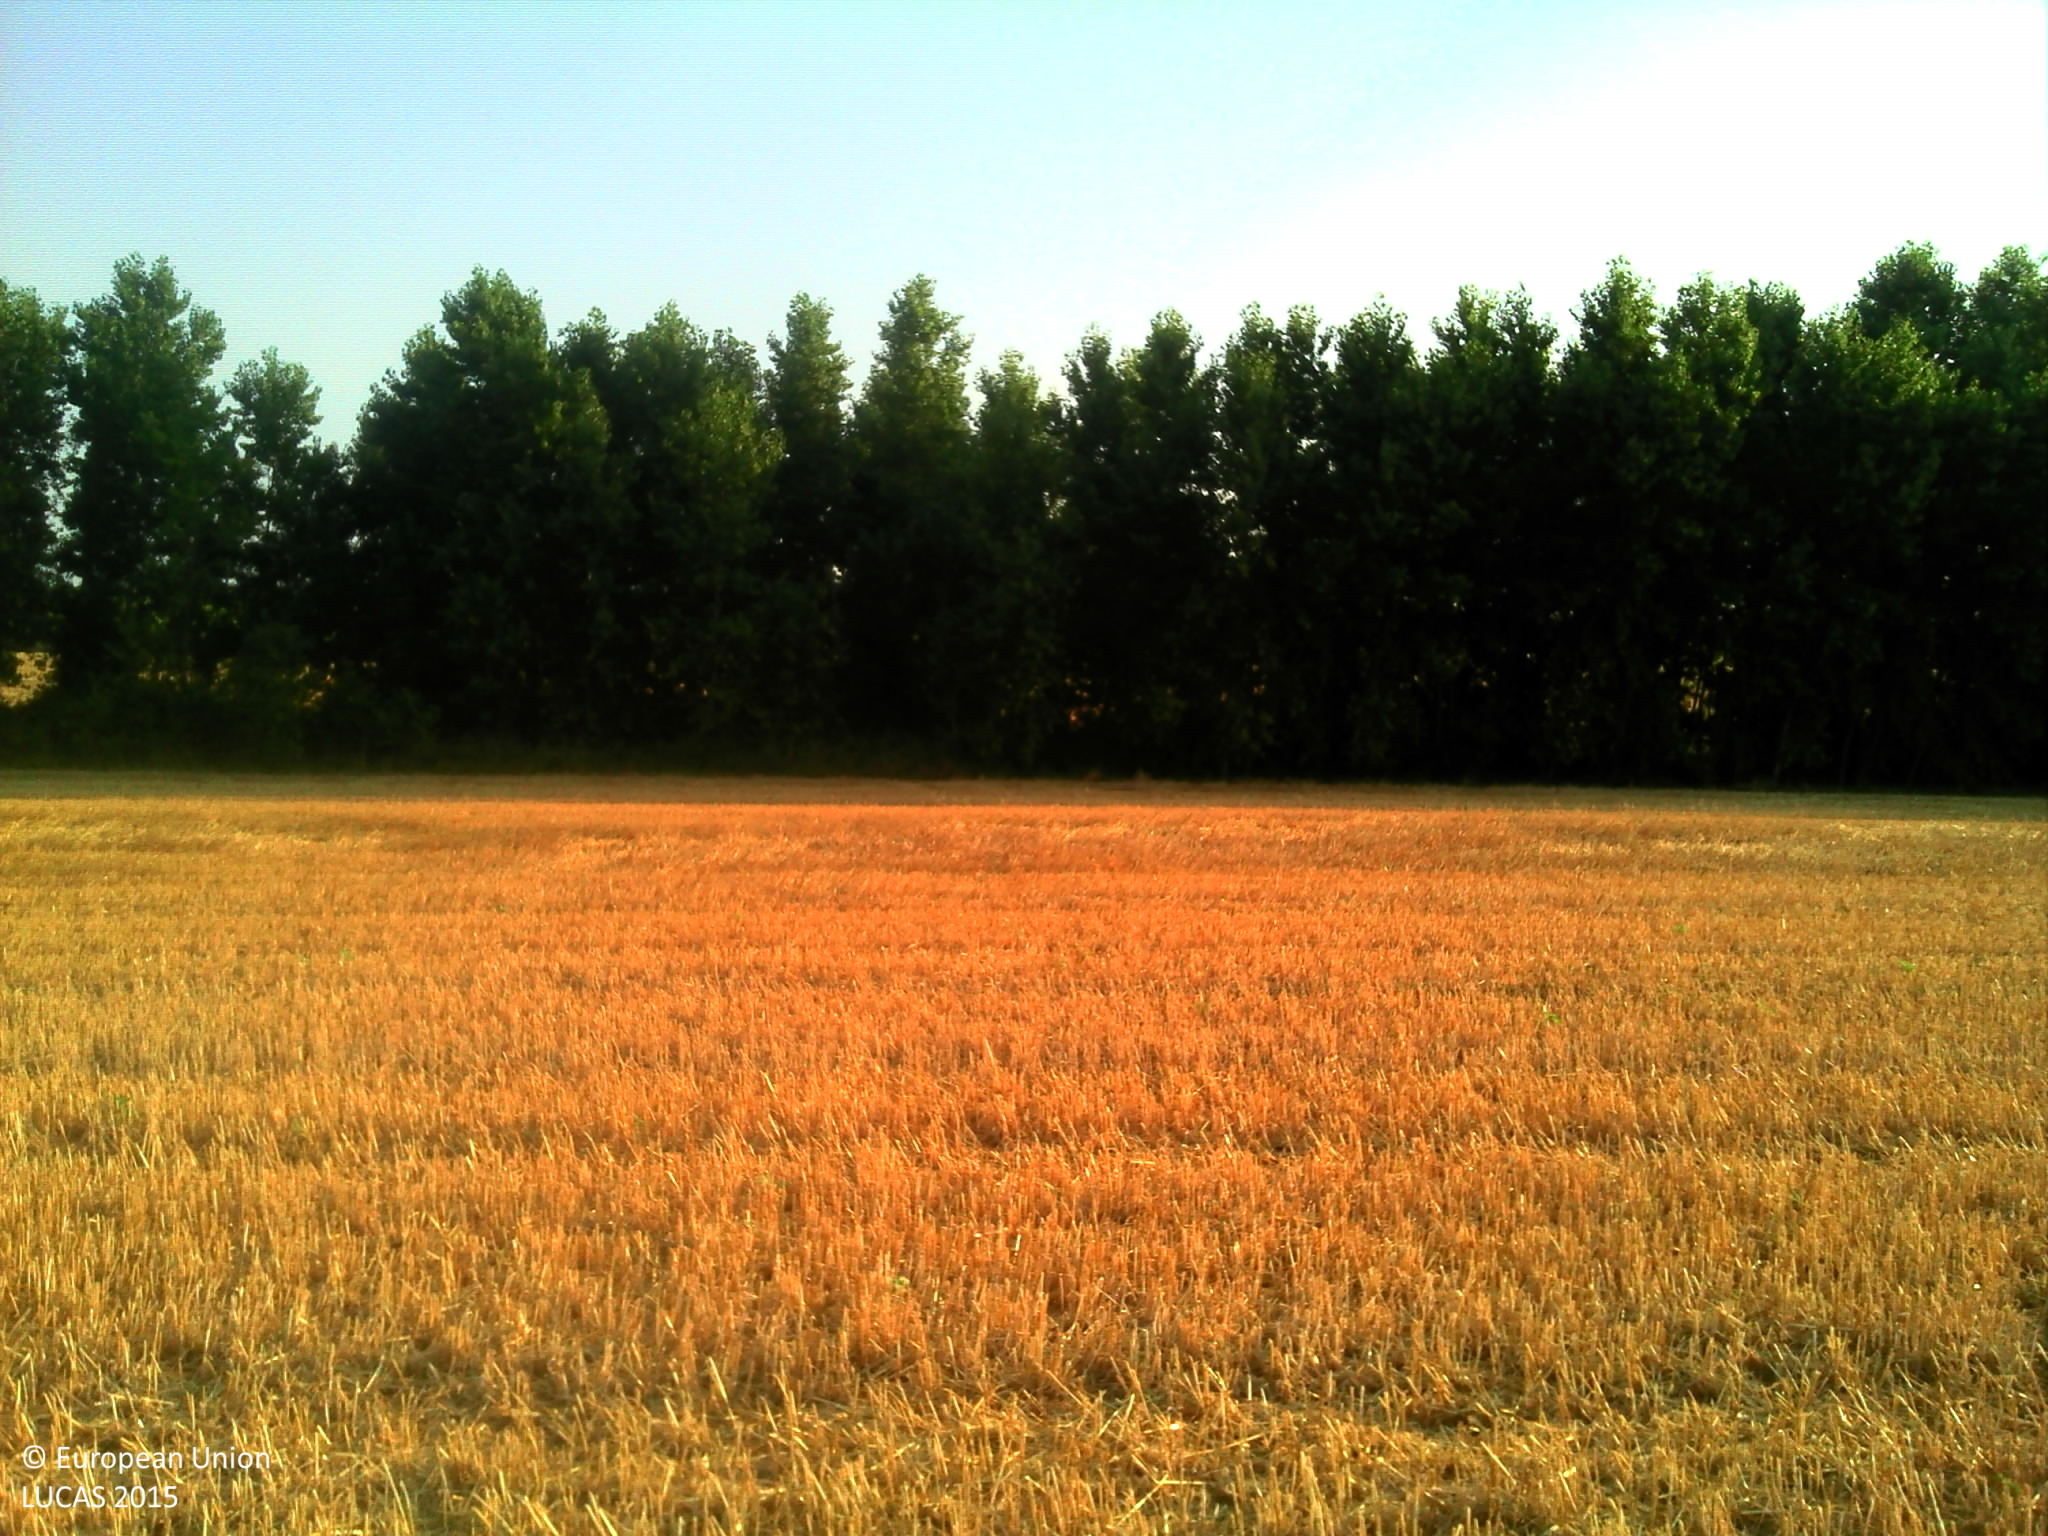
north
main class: Cropland
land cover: Durum wheat
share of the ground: > 75 %
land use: Agriculture (excluding fallow land and kitchen gardens)
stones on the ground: < 10 %
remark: Harvested field
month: July
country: FR
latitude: 45.3657
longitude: -0.6317
